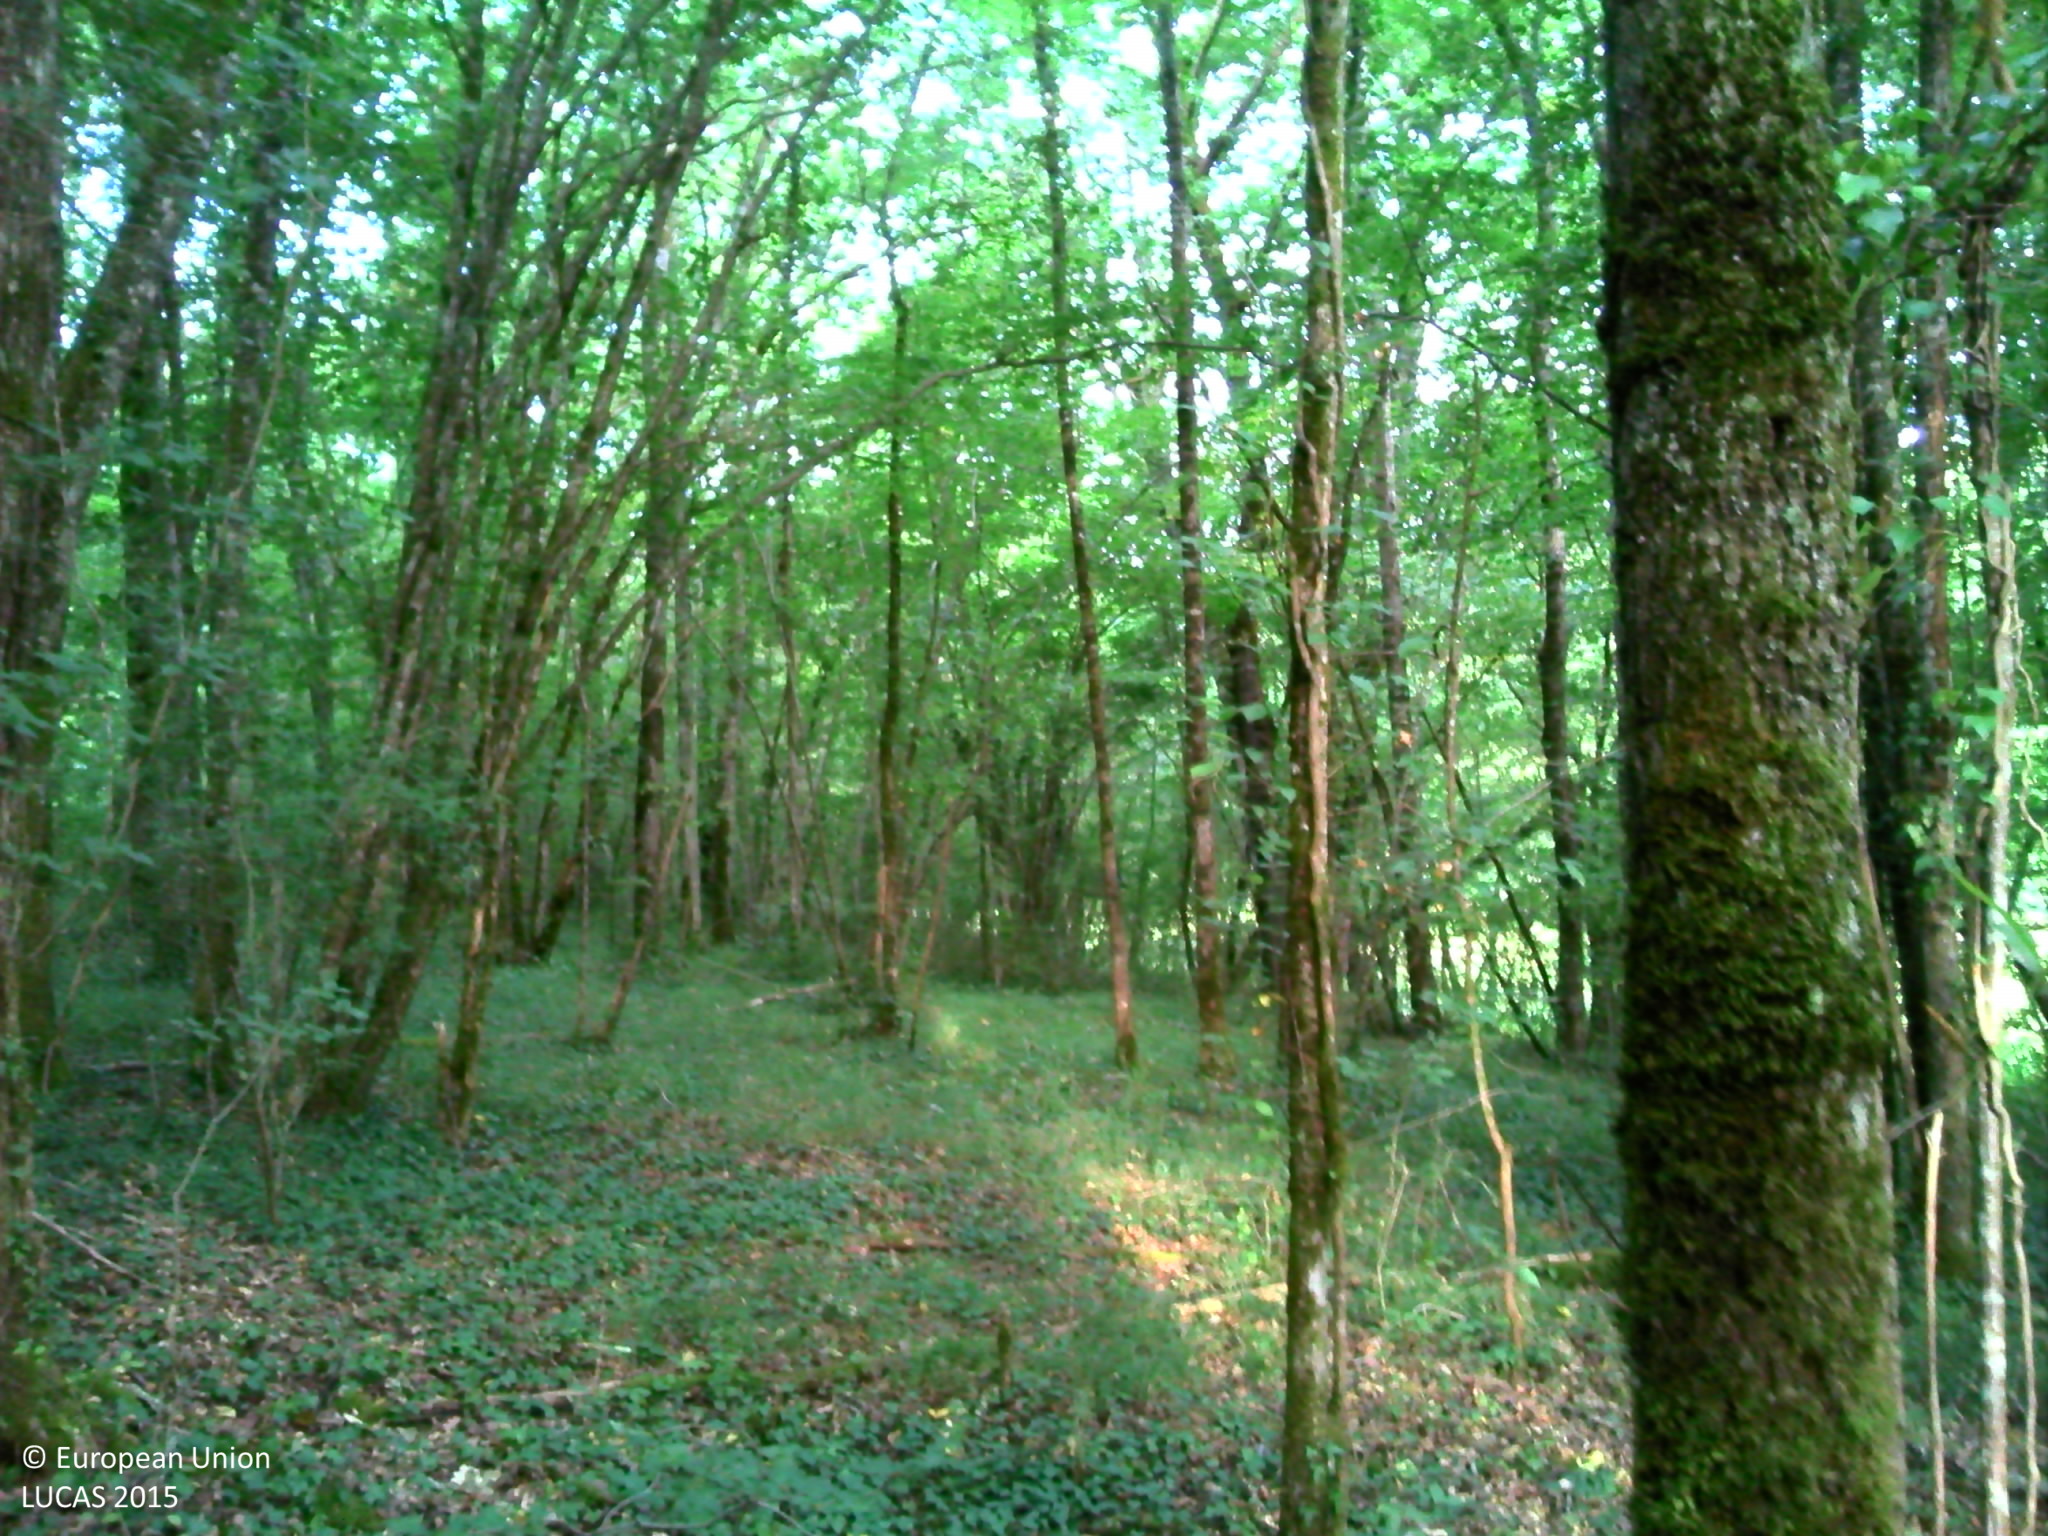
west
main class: Woodland
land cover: Broadleaved woodland
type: acidophilous oak and oak-birch forest
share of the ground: > 75 %
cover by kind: broadleaved forest trees 75 %, herbaceous plants 20 %, shrubs 5 %
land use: Forestry
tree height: > 5 m
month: July
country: FR
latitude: 44.8608
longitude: 0.9447
